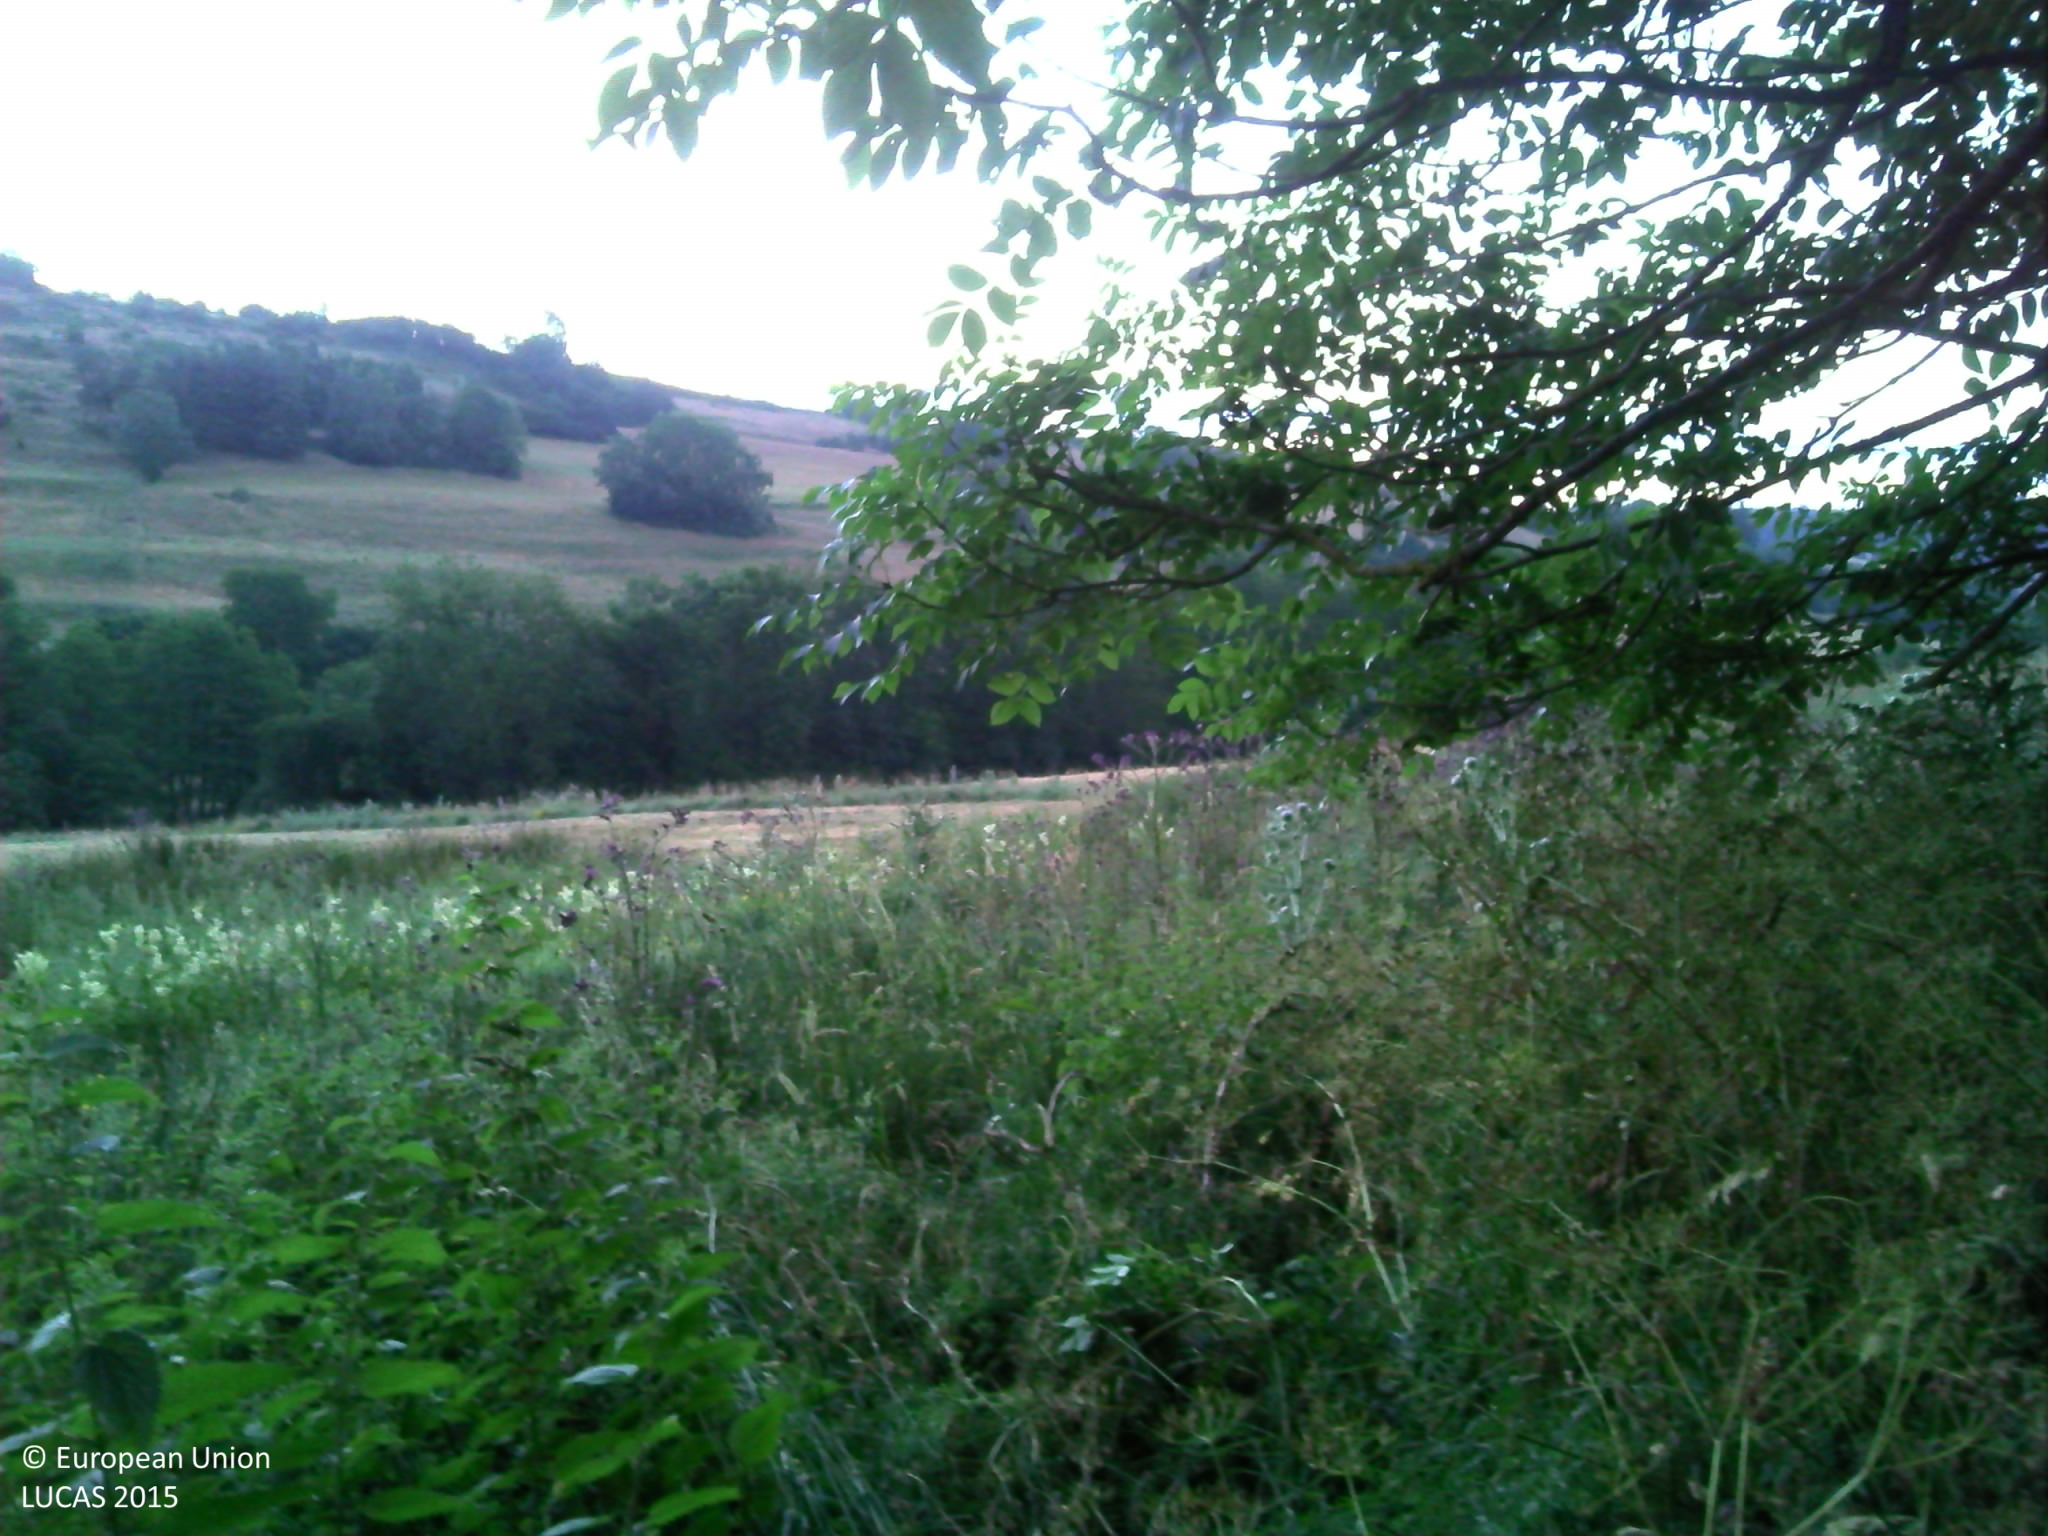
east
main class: Woodland
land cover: Broadleaved woodland
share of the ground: > 75 %
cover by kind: broadleaved forest trees 70 %, herbaceous plants 20 %, shrubs 10 %
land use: Agriculture (excluding fallow land and kitchen gardens)
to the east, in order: Broadleaved woodland; Spontaneously vegetated surfaces; Grassland without tree/shrub cover; Fences; Grassland without tree/shrub cover; Broadleaved woodland; Spontaneously vegetated surfaces; Fences; Abandoned hedges; Rivers and streams; Abandoned hedges; Fences; Grassland without tree/shrub cover
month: July
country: FR
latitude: 45.1044
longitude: 3.2030
